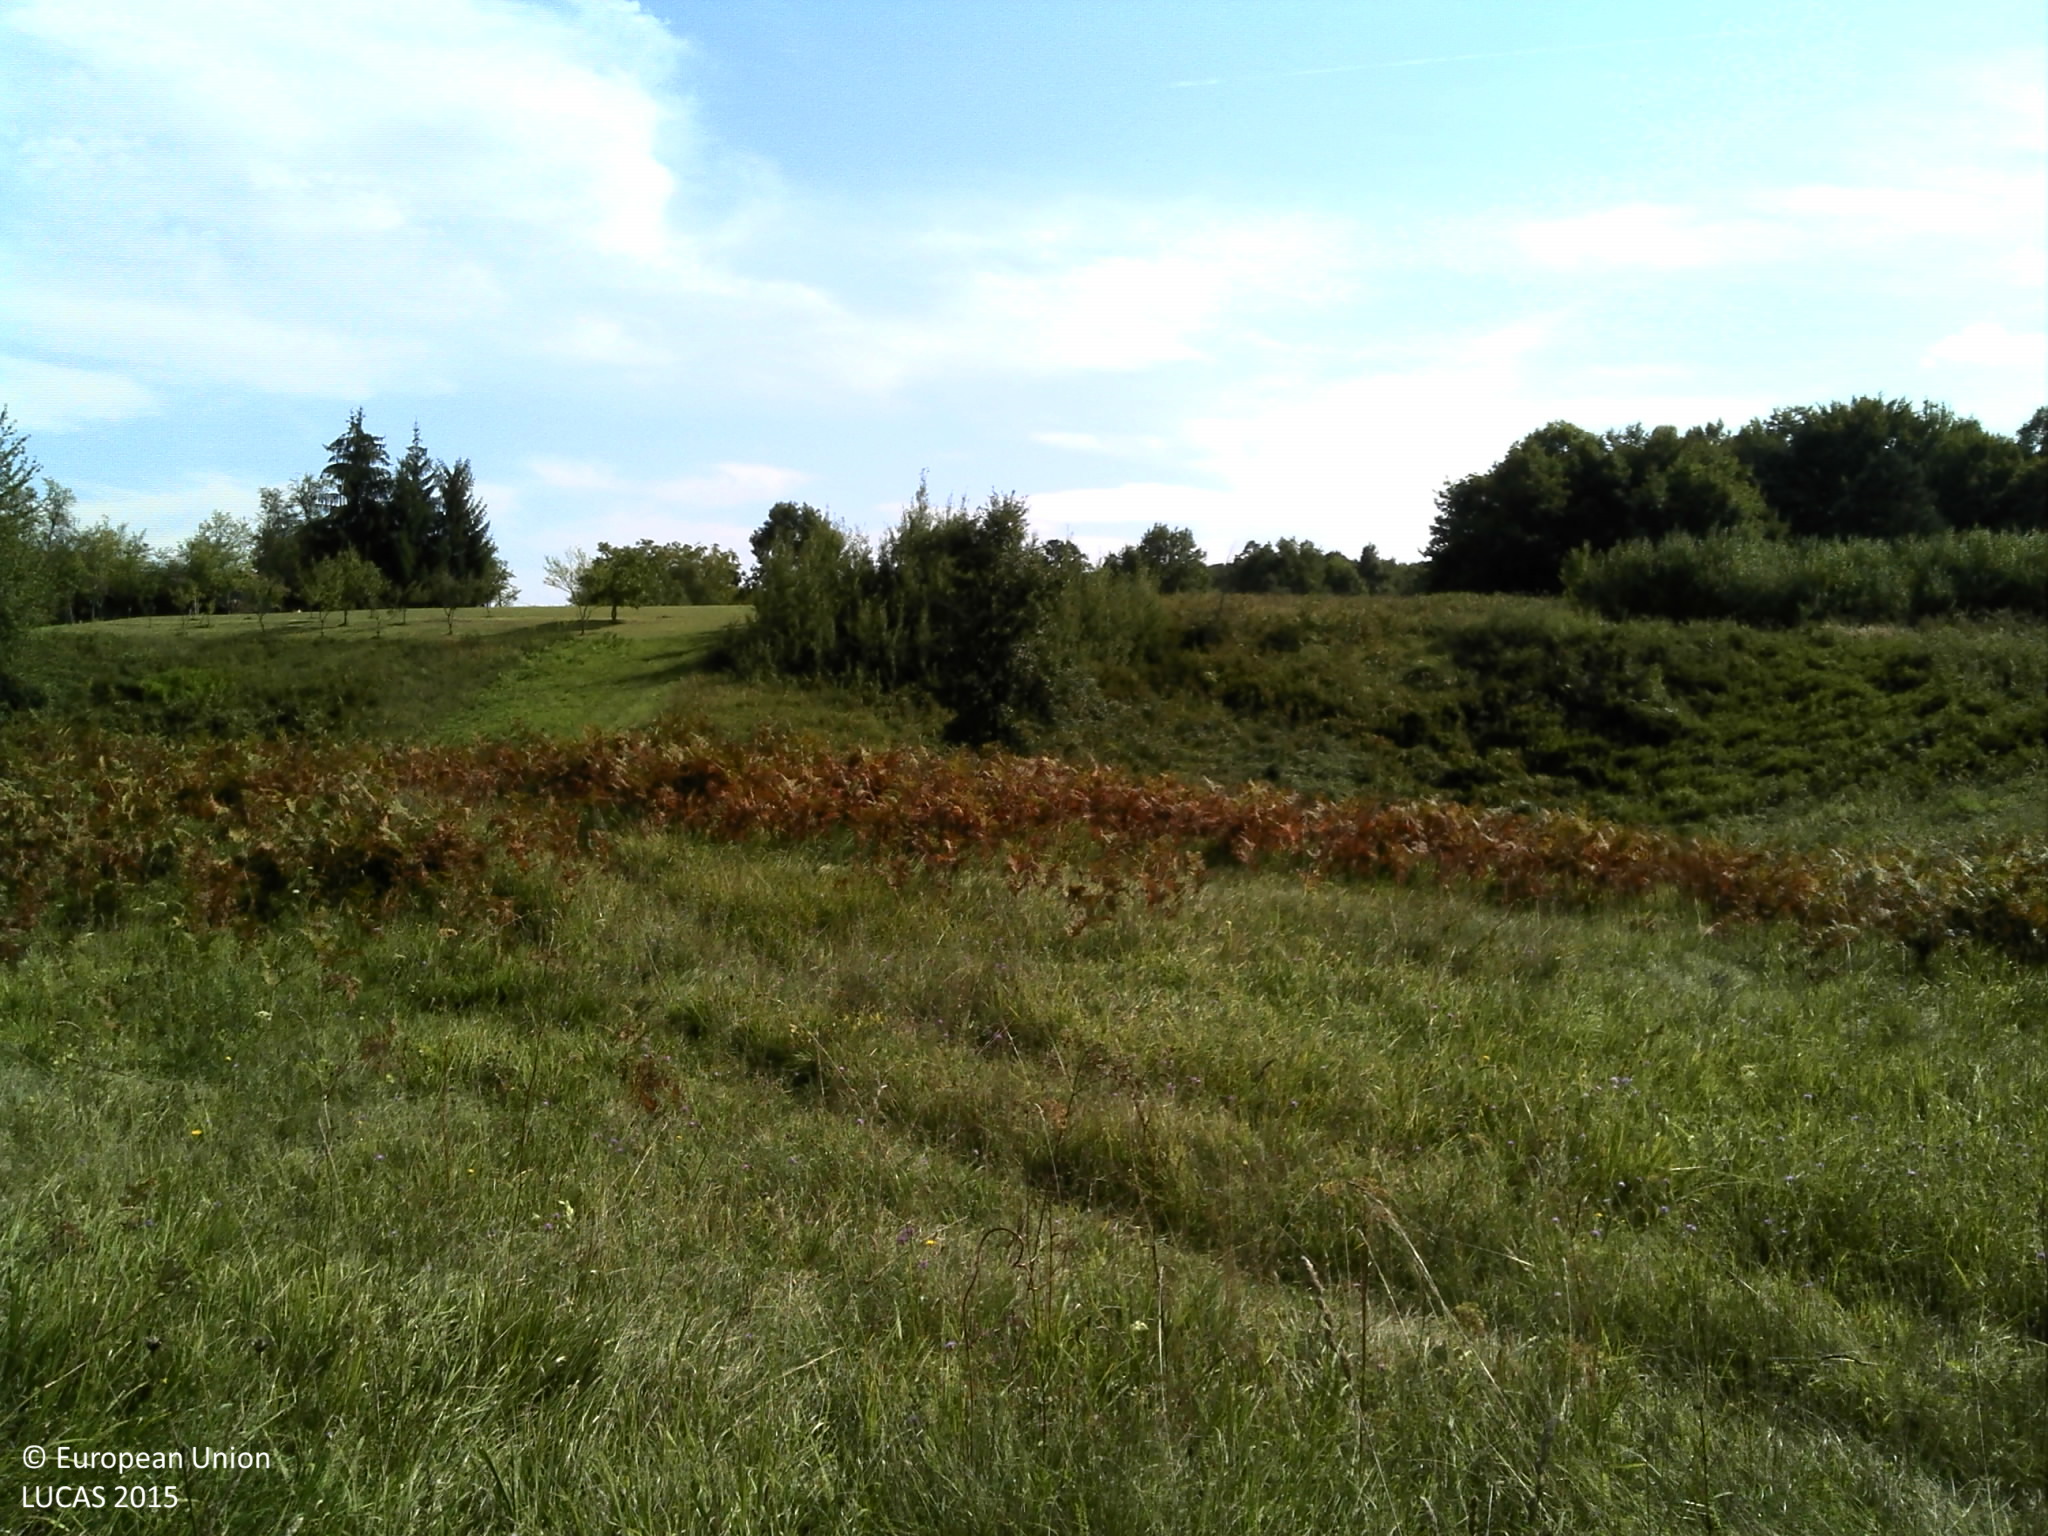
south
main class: Grassland
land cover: Grassland with sparse tree/shrub cover
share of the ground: > 75 %
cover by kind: herbaceous plants 95 %, broadleaved forest trees 5 %
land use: Semi-natural and natural areas not in use
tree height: < 5 m
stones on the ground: < 10 %
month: September
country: HR
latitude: 45.0988
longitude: 15.6757
